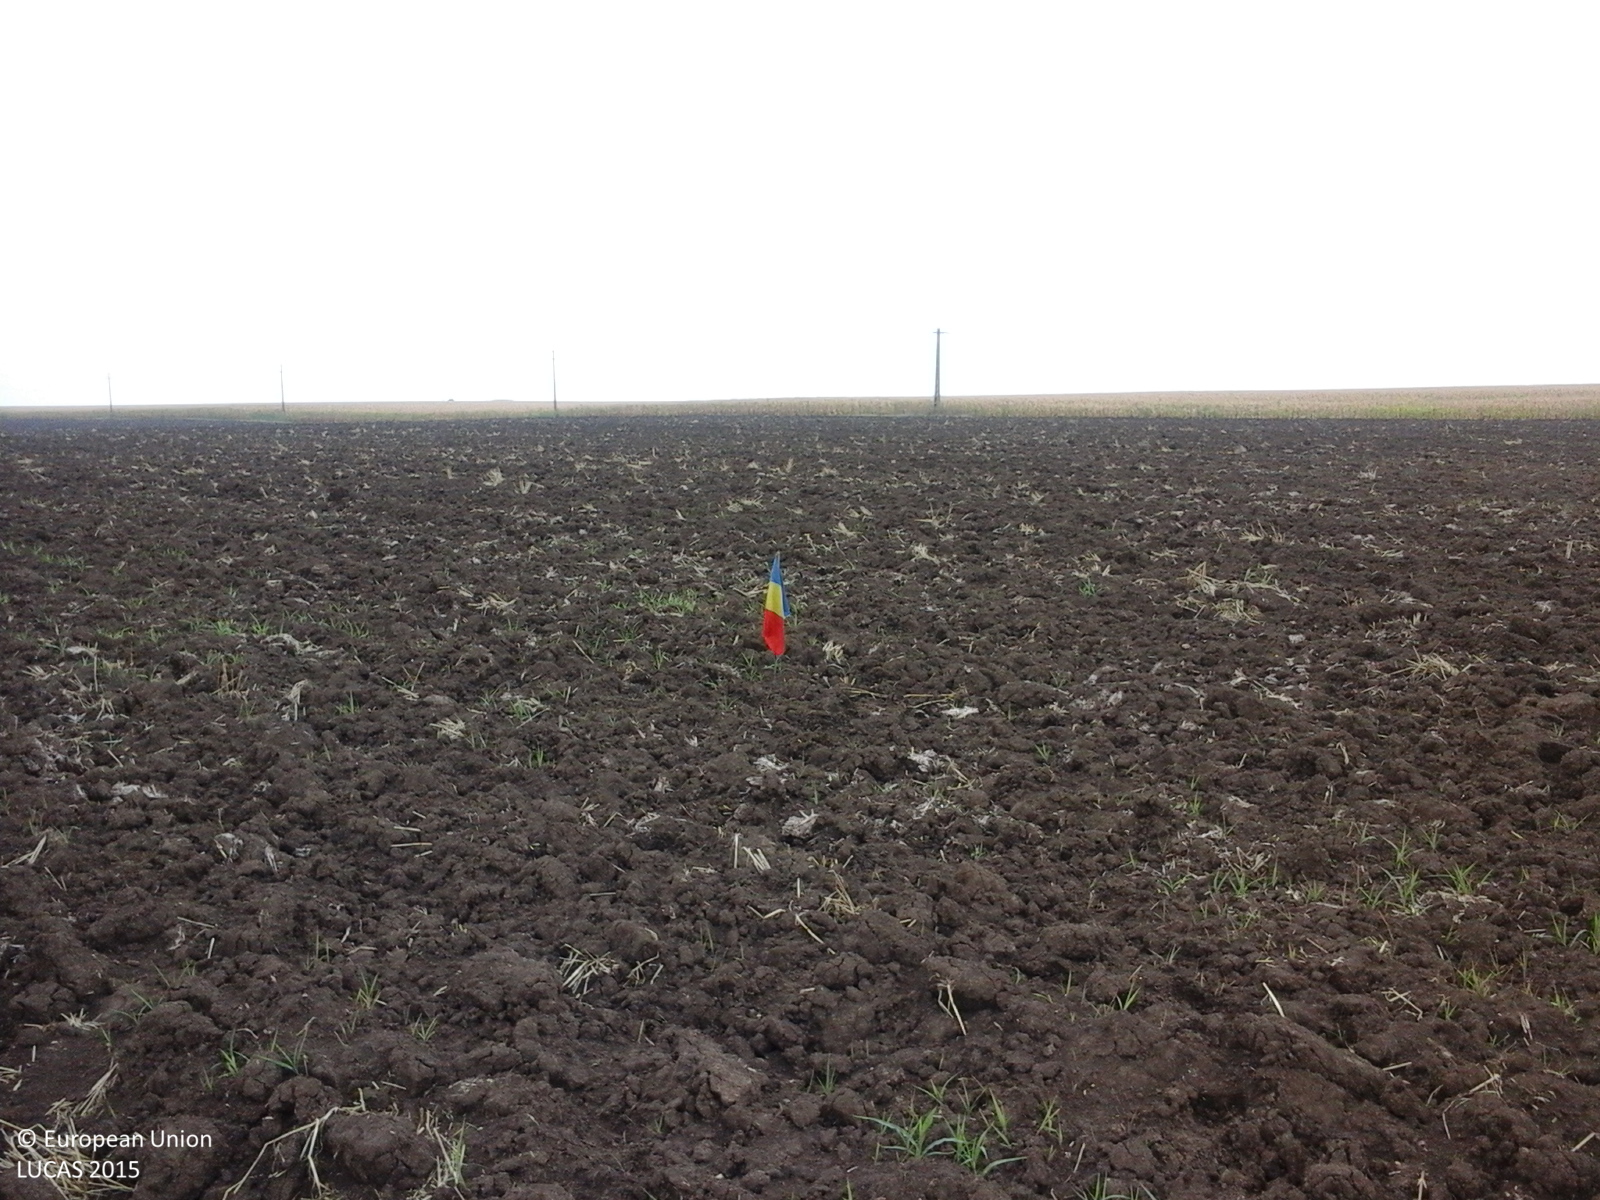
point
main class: Cropland
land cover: Common wheat
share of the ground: < 10 %
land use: Agriculture (excluding fallow land and kitchen gardens)
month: August
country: RO
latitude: 45.9449
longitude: 21.0067
